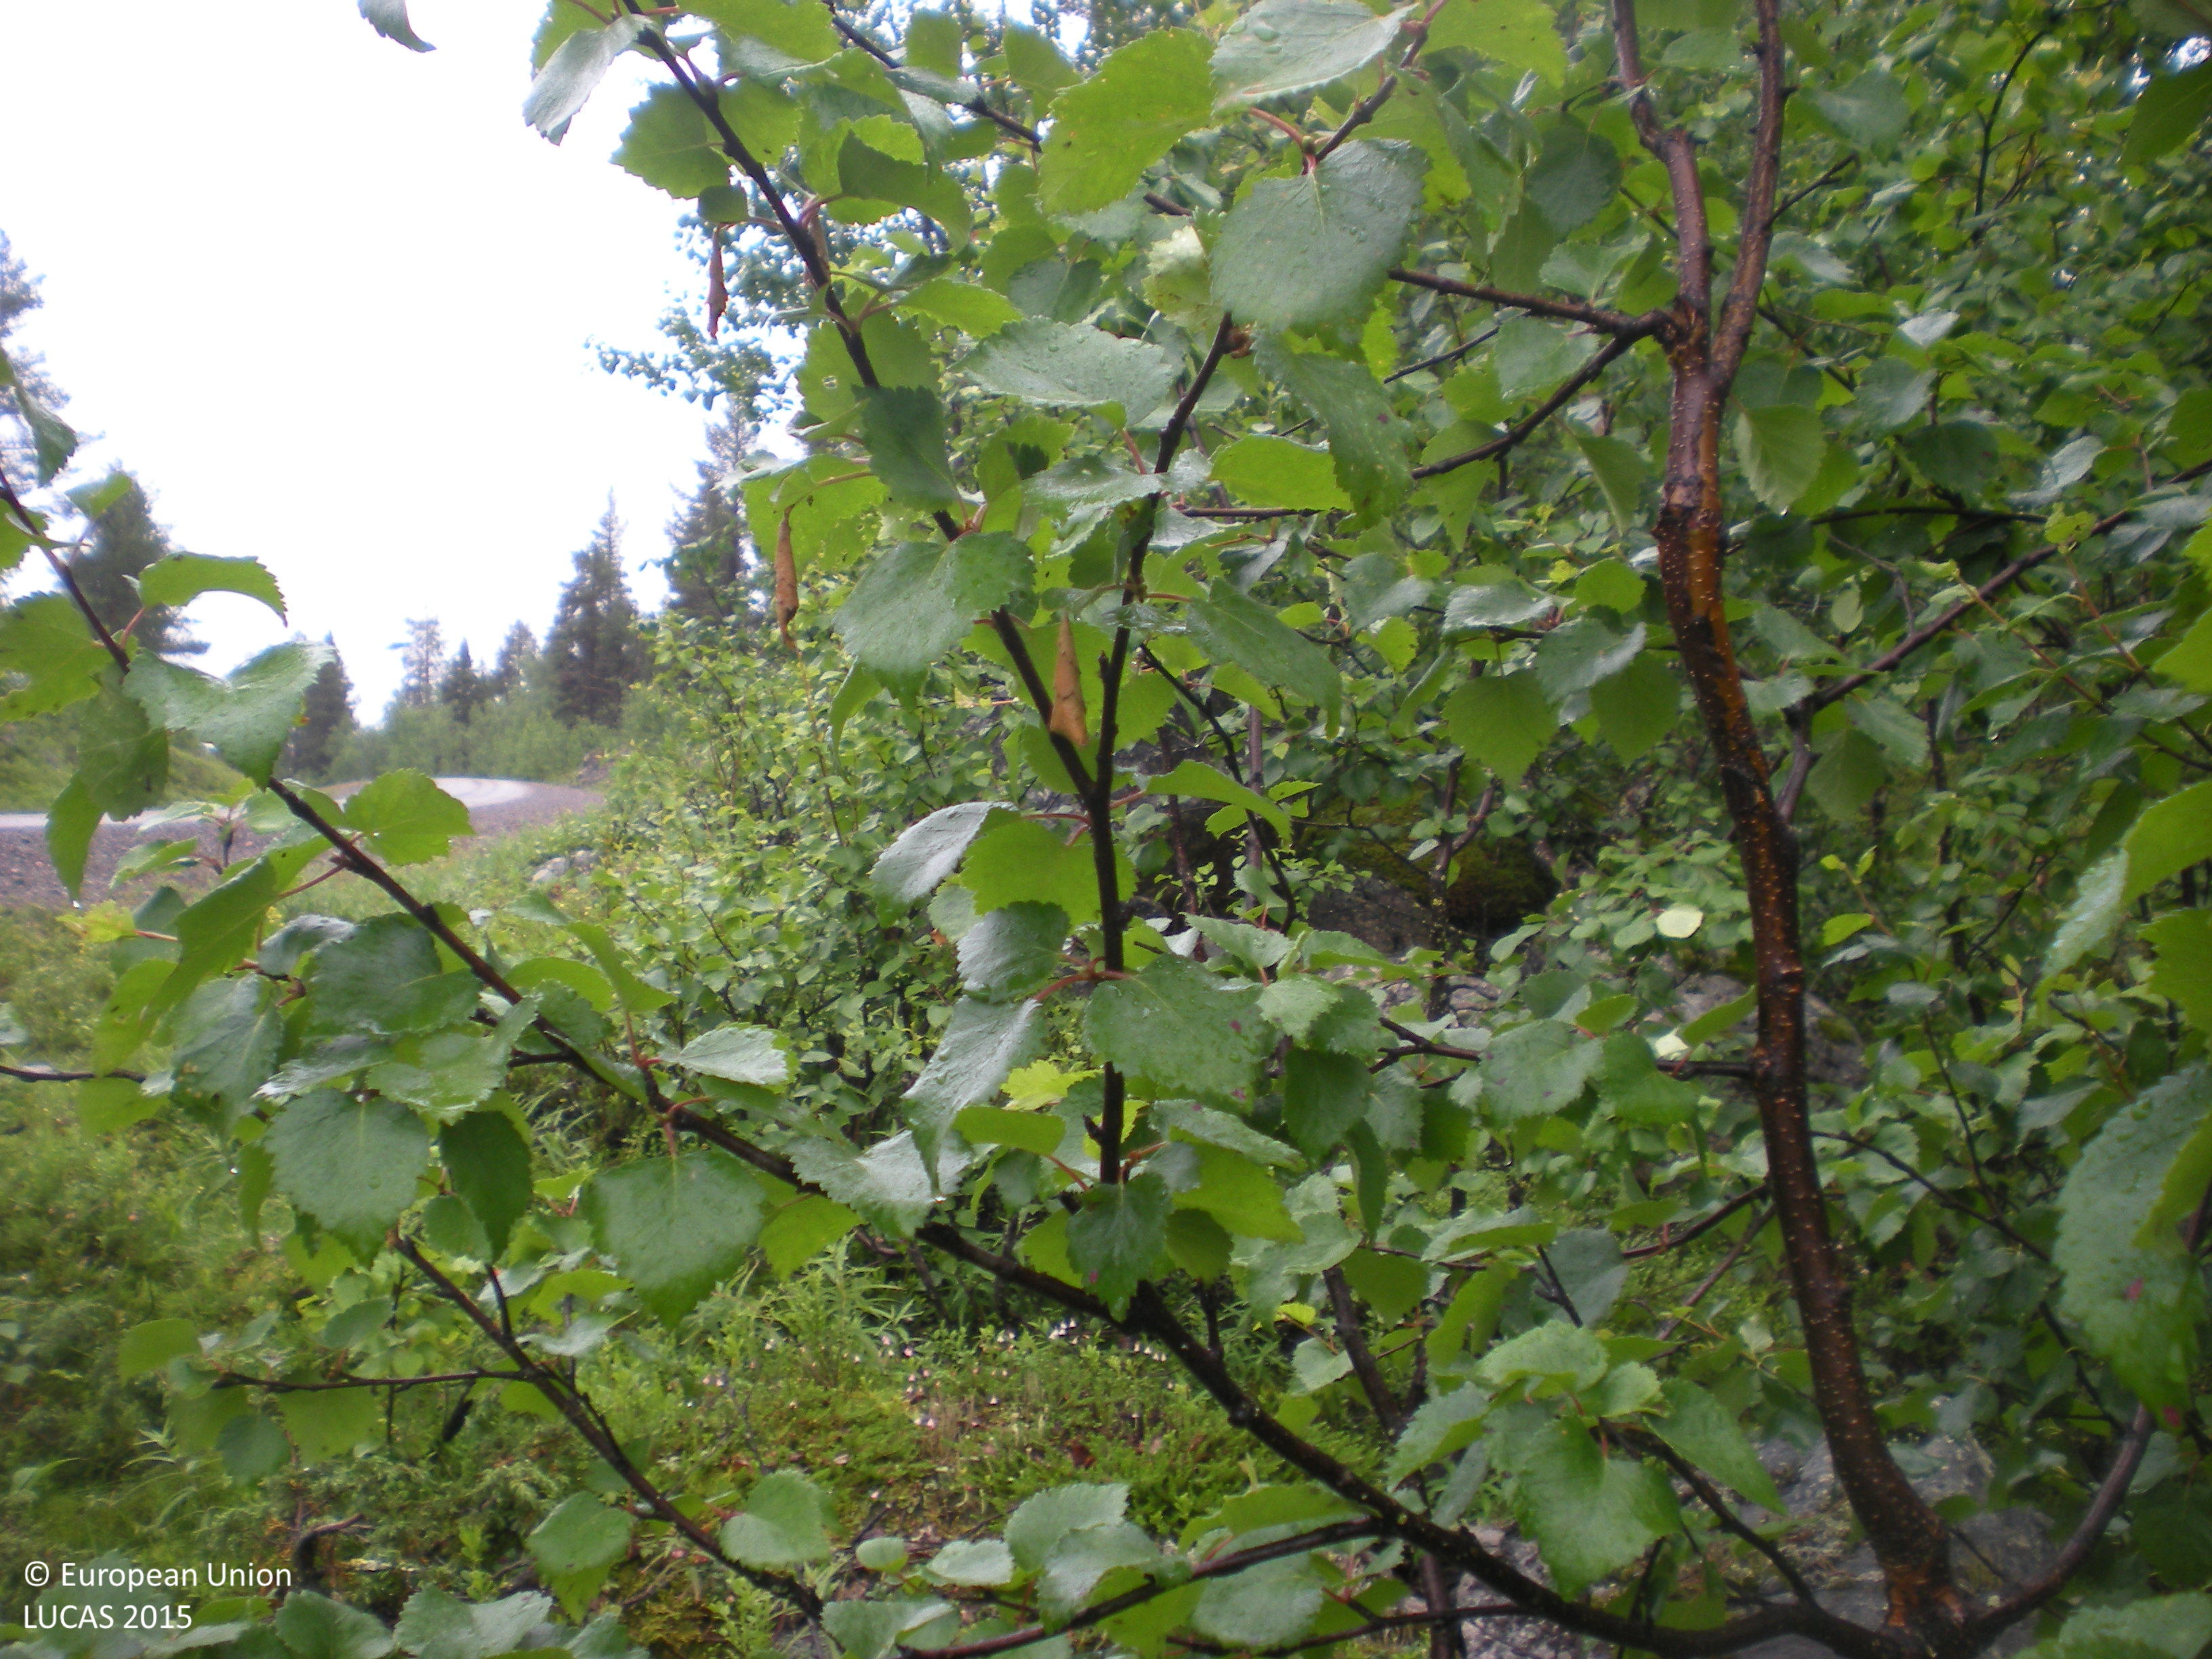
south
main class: Woodland
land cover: Broadleaved woodland
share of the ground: 25 - 50 %
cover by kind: broadleaved forest trees 40 %, shrubs 35 %, herbaceous plants 15 %, consolidated bare surface 10 %
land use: Forestry
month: August
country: SE
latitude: 66.3693
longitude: 17.7998
